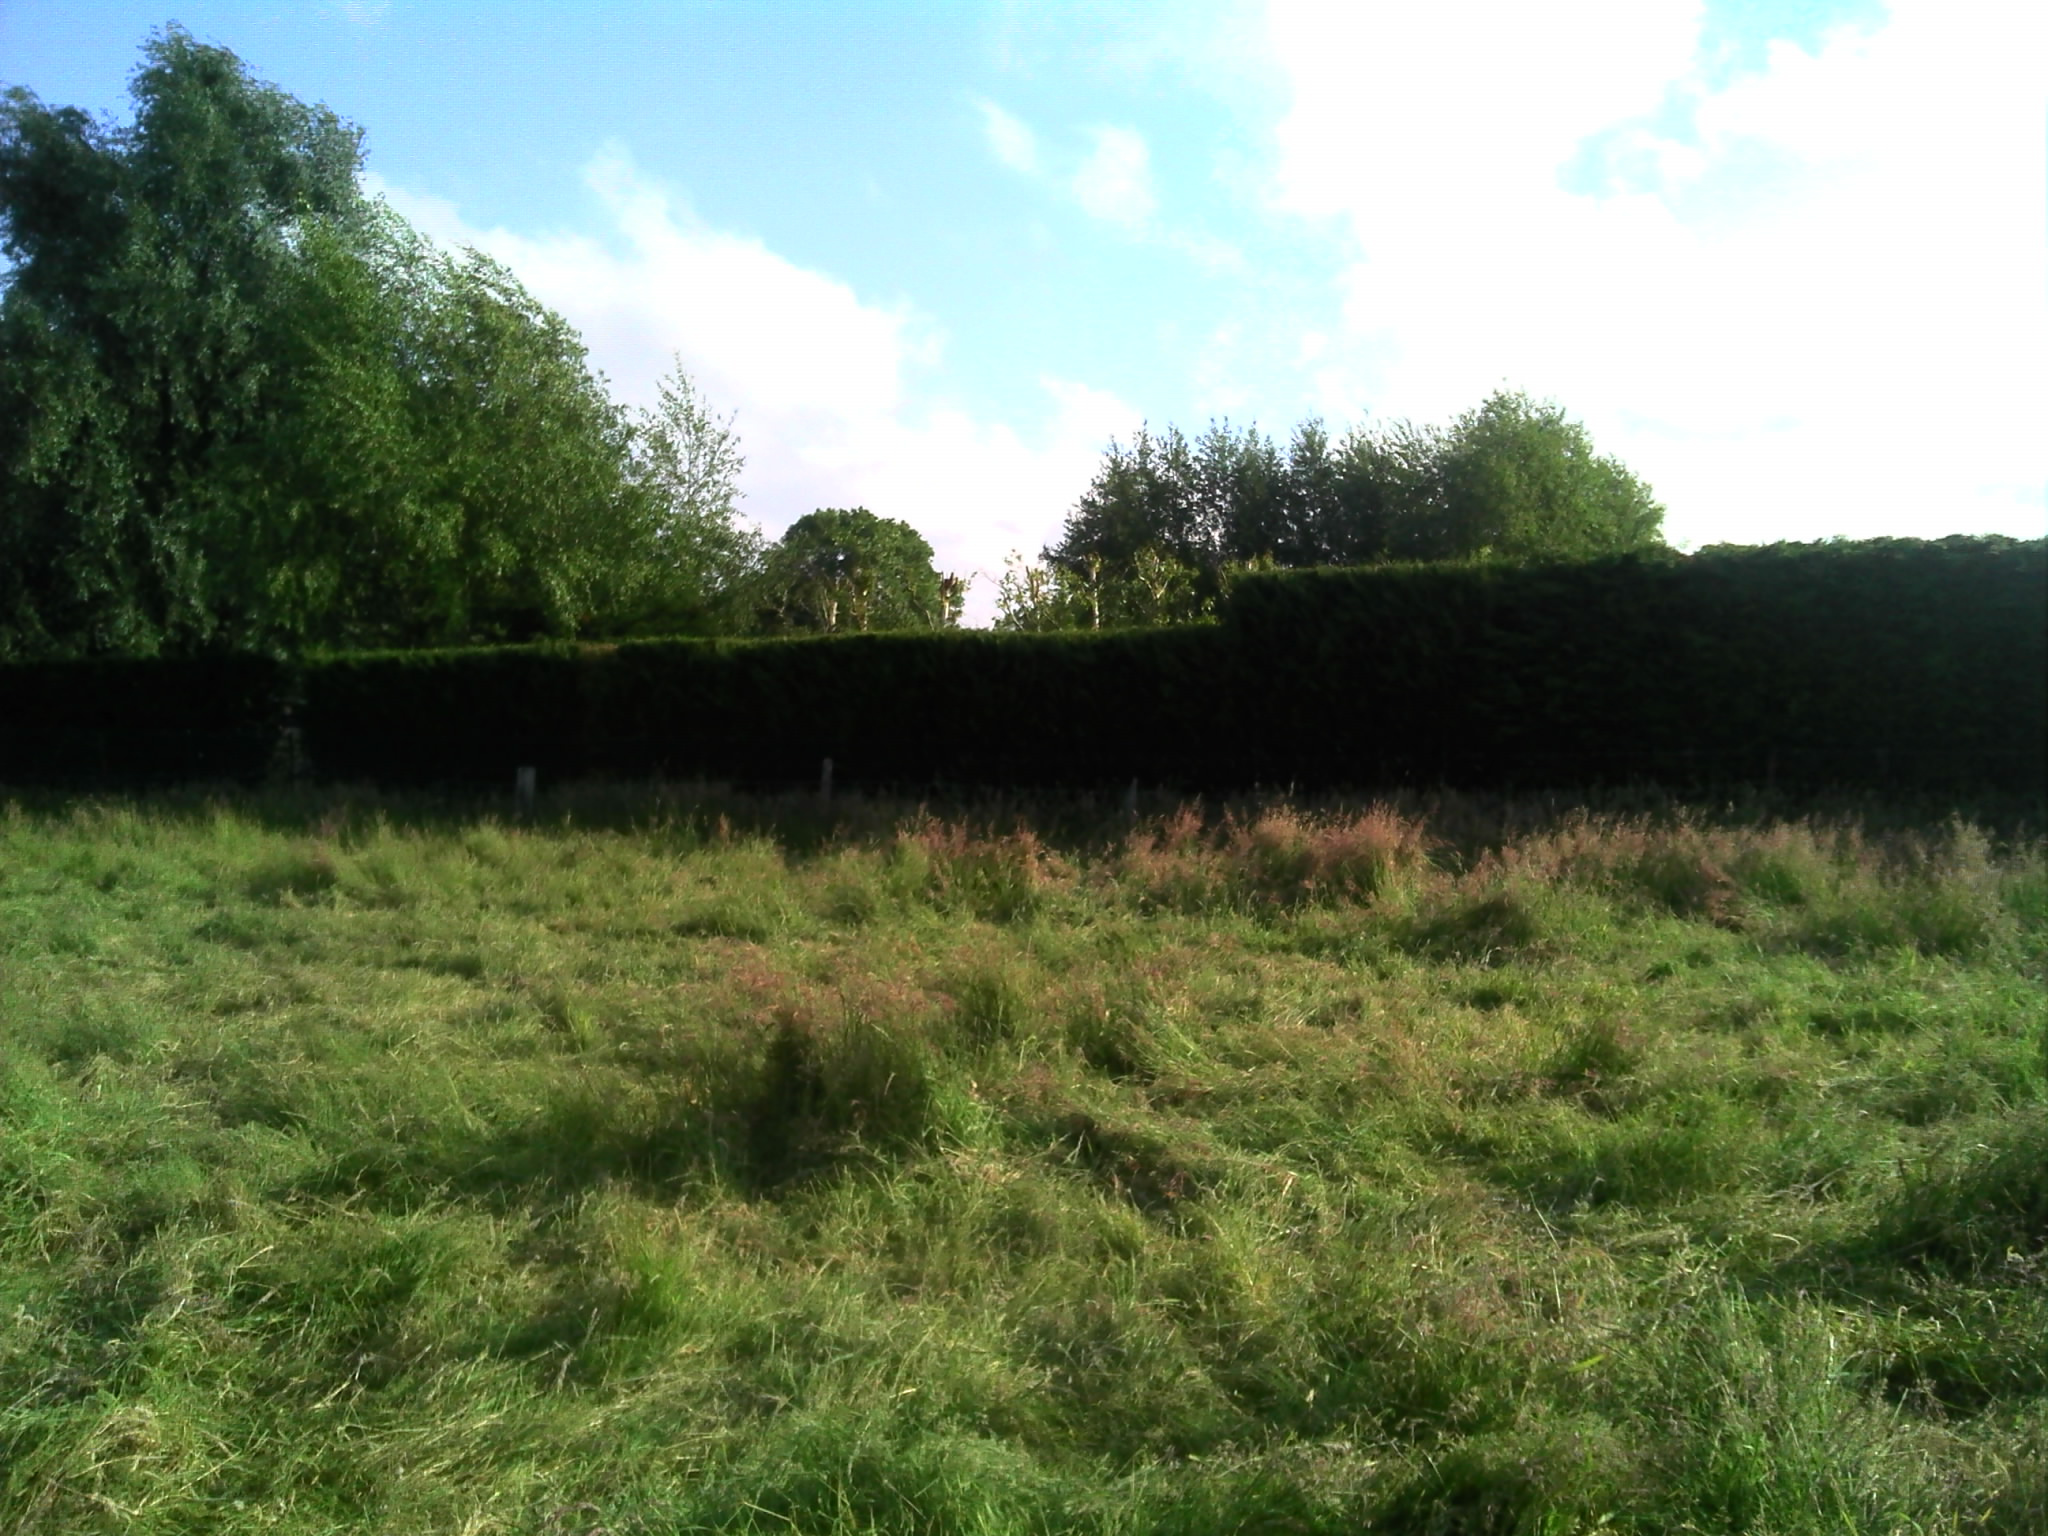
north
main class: Grassland
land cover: Grassland without tree/shrub cover
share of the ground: > 75 %
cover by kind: herbaceous plants 100 %
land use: Agriculture (excluding fallow land and kitchen gardens)
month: June
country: BE
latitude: 50.3903
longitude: 4.8065
